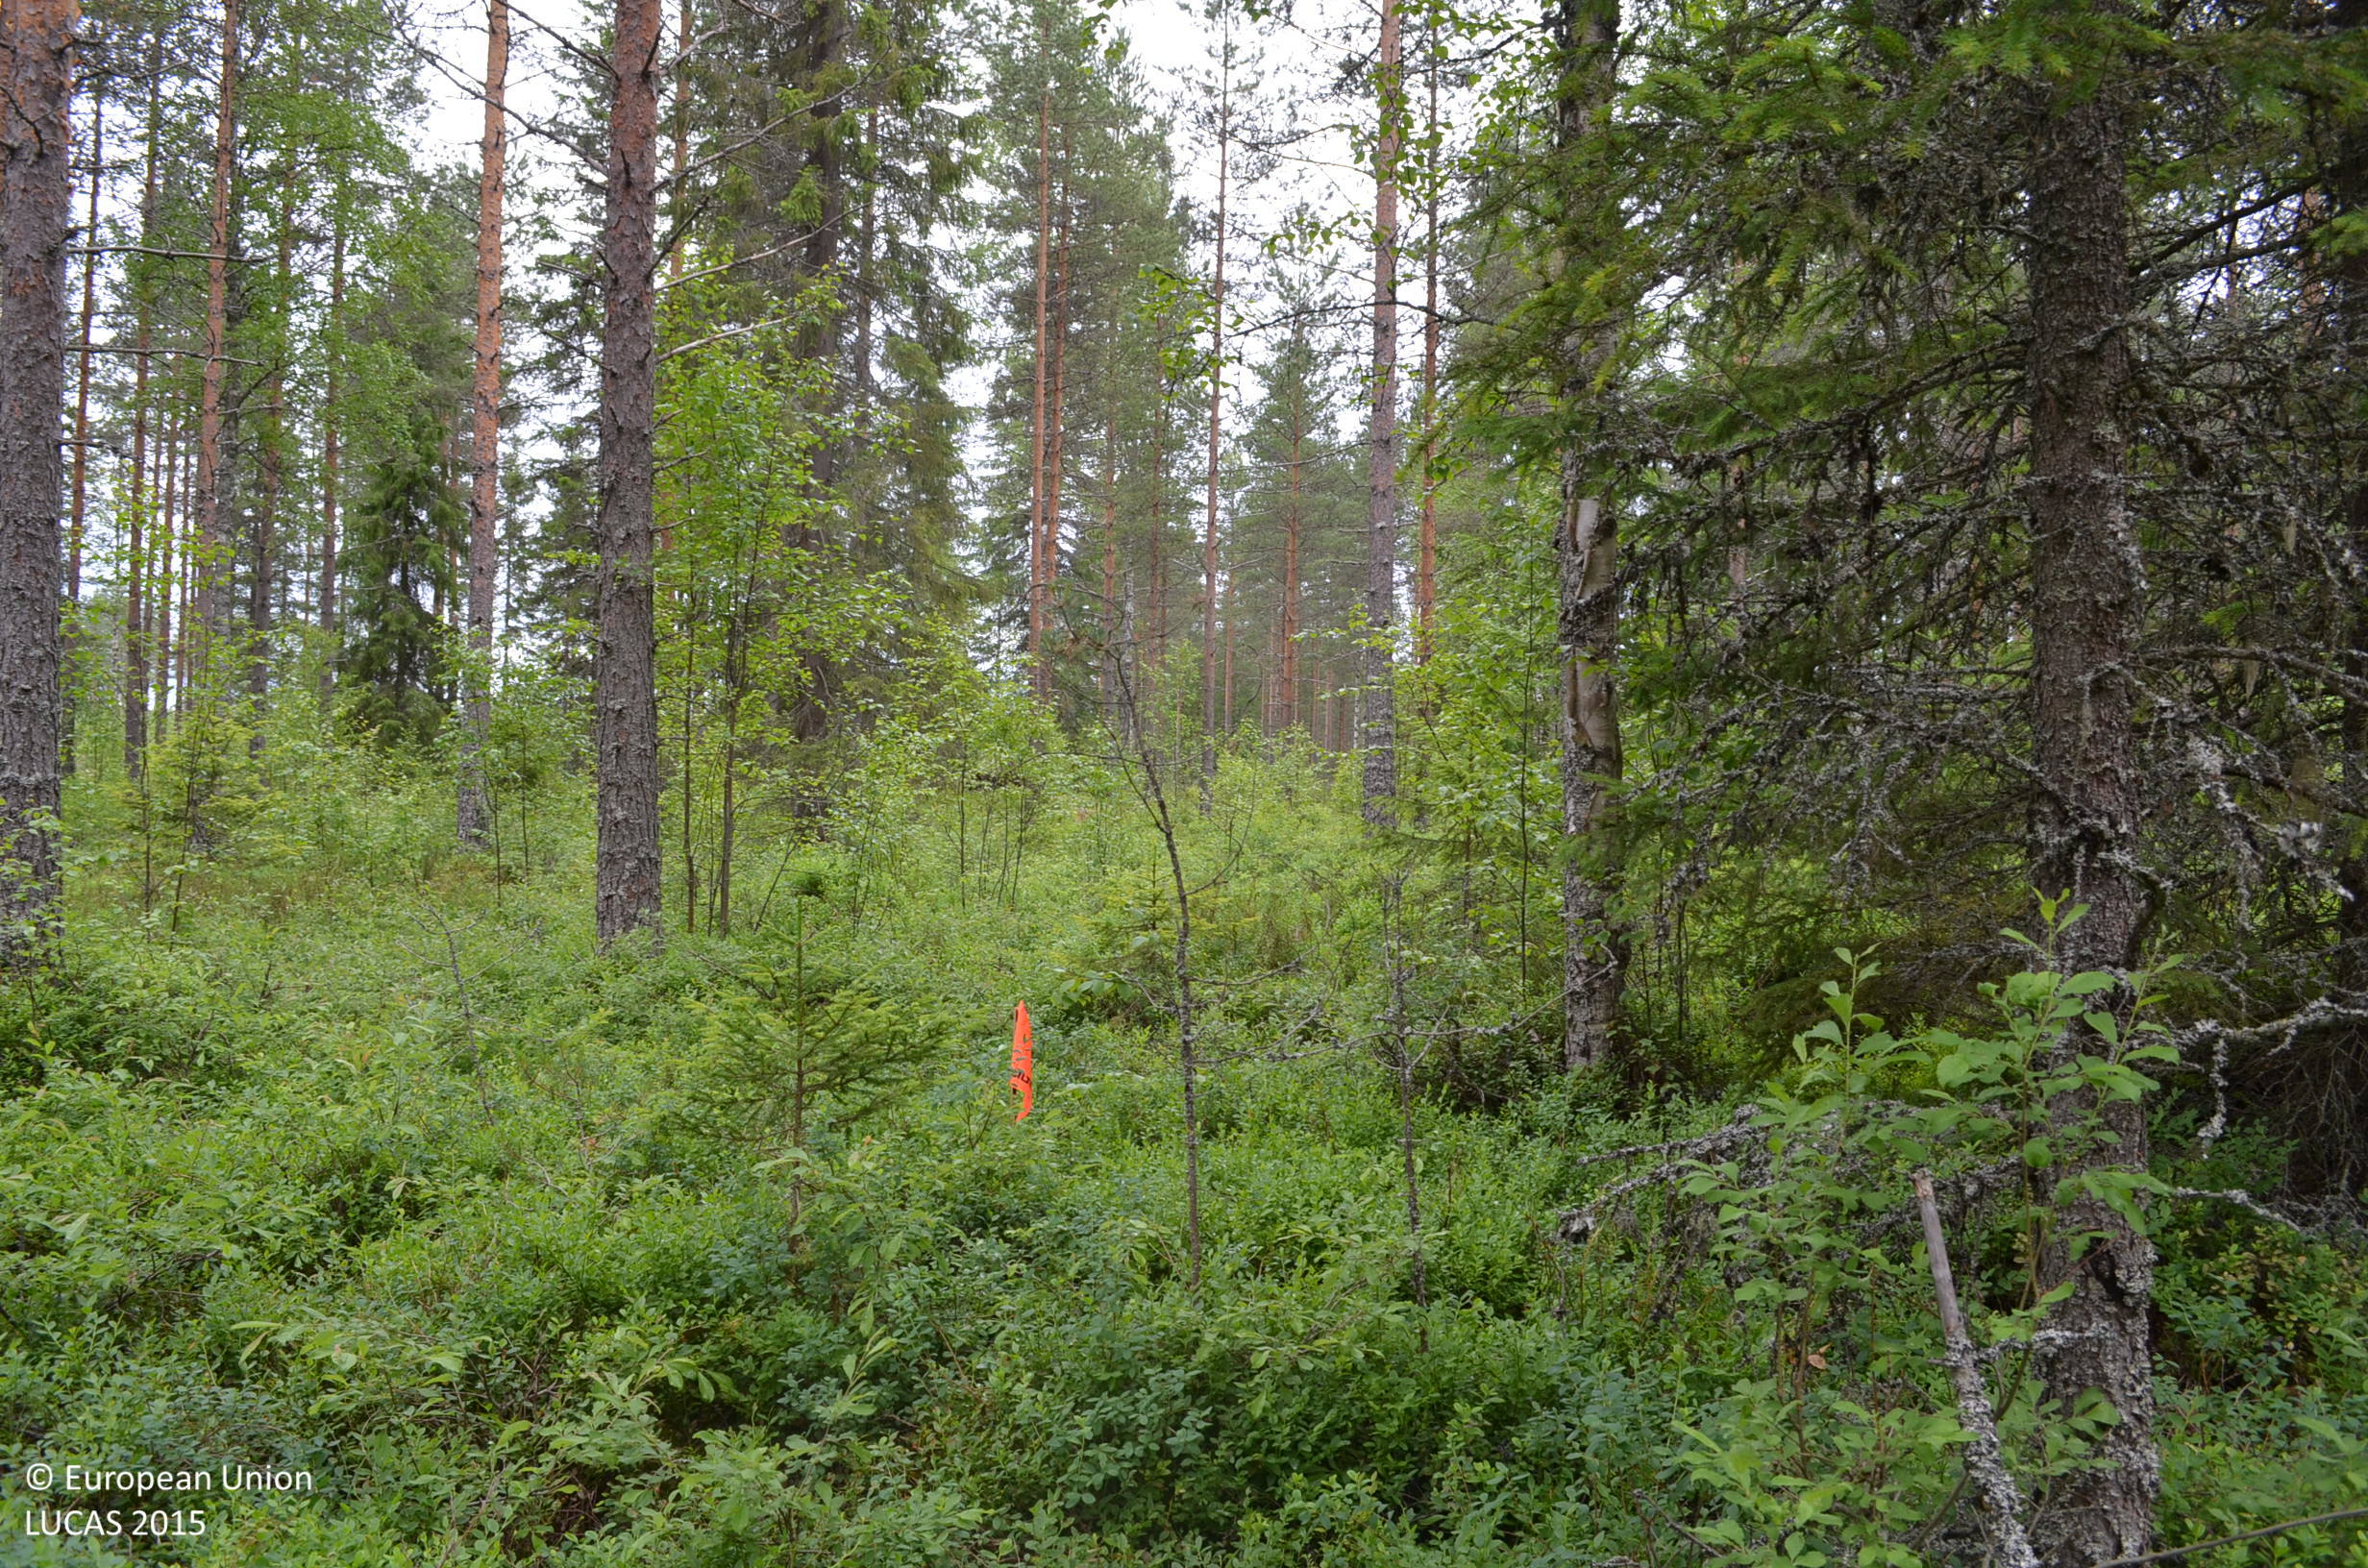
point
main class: Woodland
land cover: Pine dominated coniferous woodland
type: boreal forest
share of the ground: 50 - 75 %
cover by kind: coniferous forest trees 55 %, shrubs 35 %, broadleaved forest trees 10 %
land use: Forestry
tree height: > 5 m
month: July
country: FI
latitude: 62.2722
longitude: 23.5405
